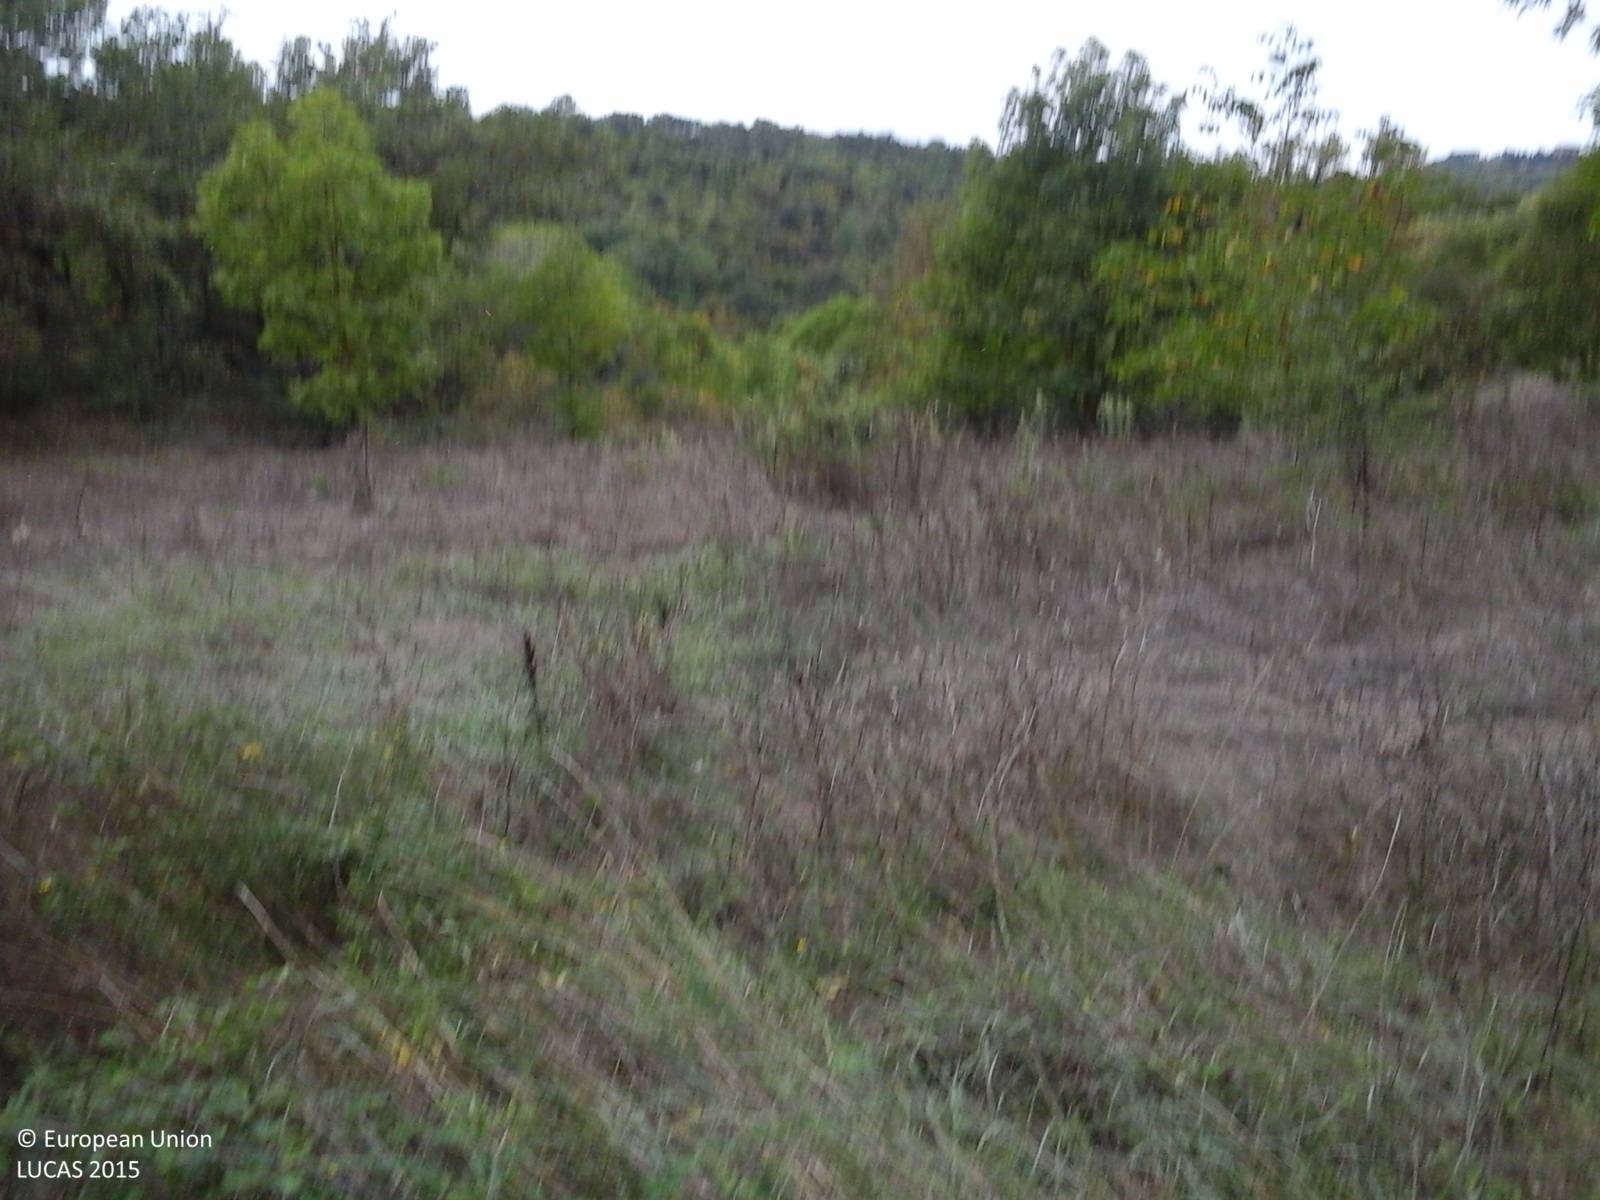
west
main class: Woodland
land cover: Broadleaved woodland
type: thermophilous deciduous forest
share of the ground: > 75 %
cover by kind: broadleaved forest trees 60 %, shrubs 40 %
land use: Forestry
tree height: > 5 m
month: September
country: IT
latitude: 42.9540
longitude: 12.2608
